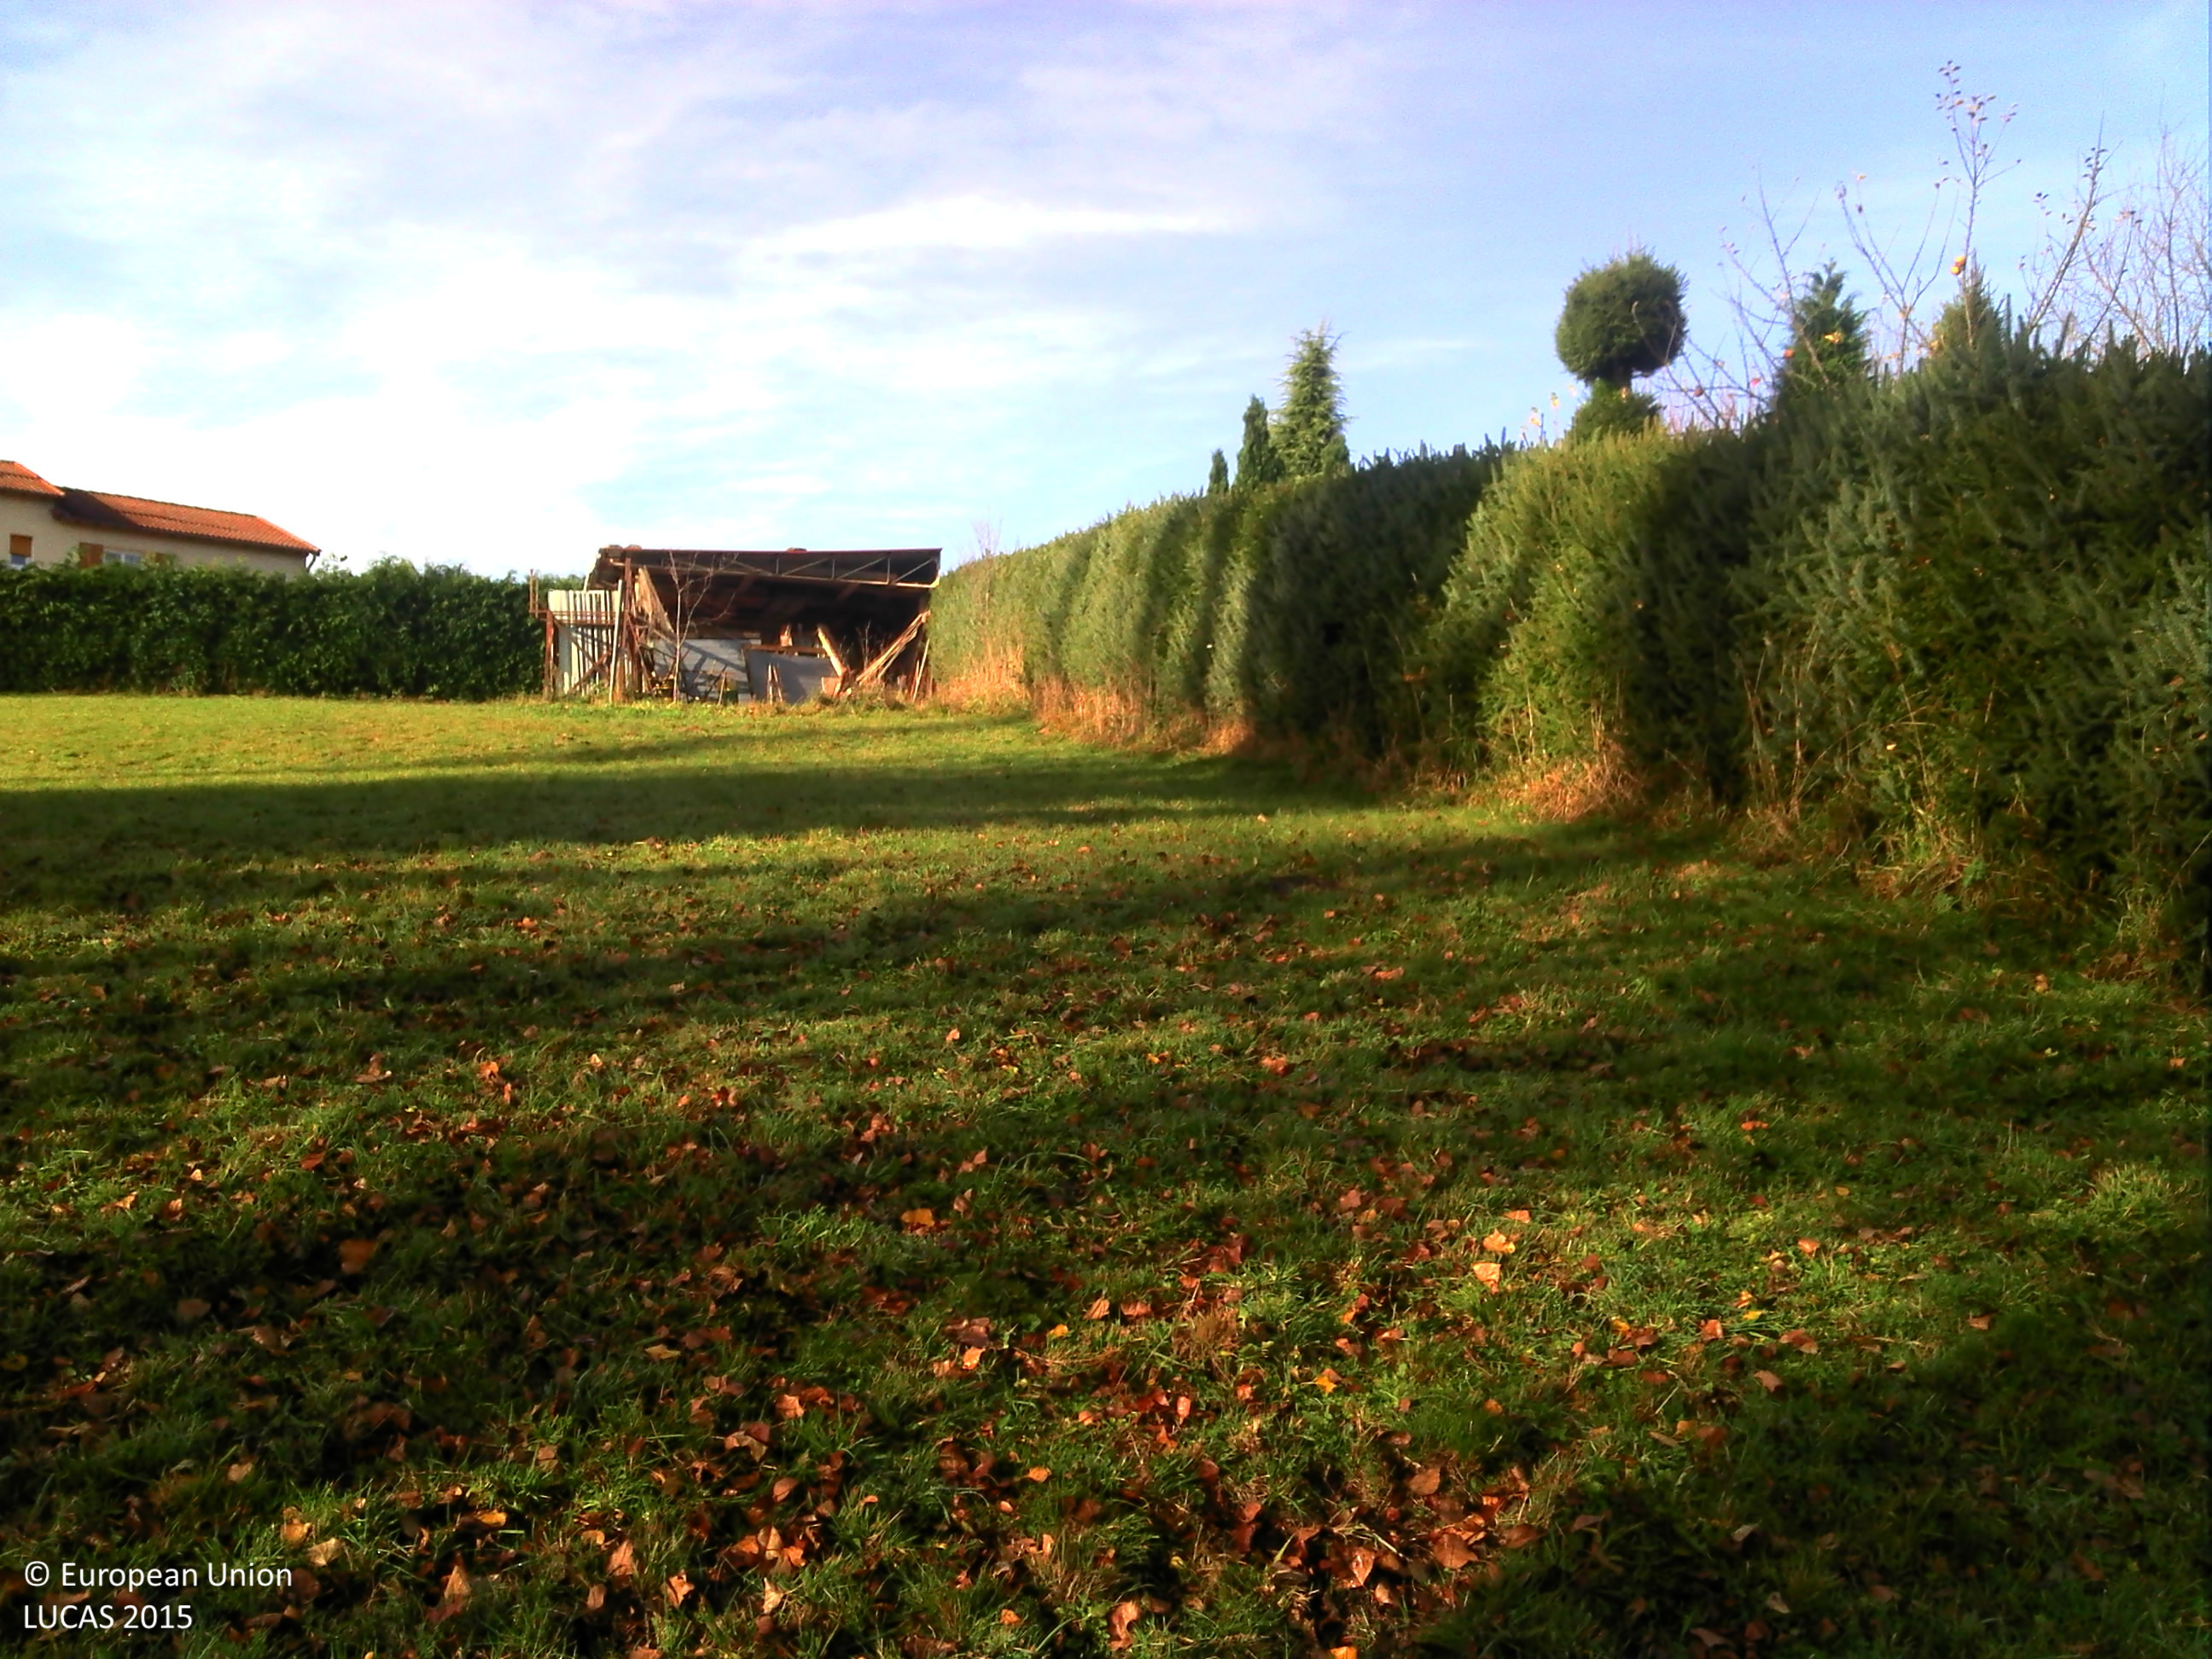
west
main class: Grassland
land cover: Grassland without tree/shrub cover
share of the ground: > 75 %
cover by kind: herbaceous plants 100 %
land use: Agriculture (excluding fallow land and kitchen gardens)
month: November
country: FR
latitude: 45.3246
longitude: 3.8410
